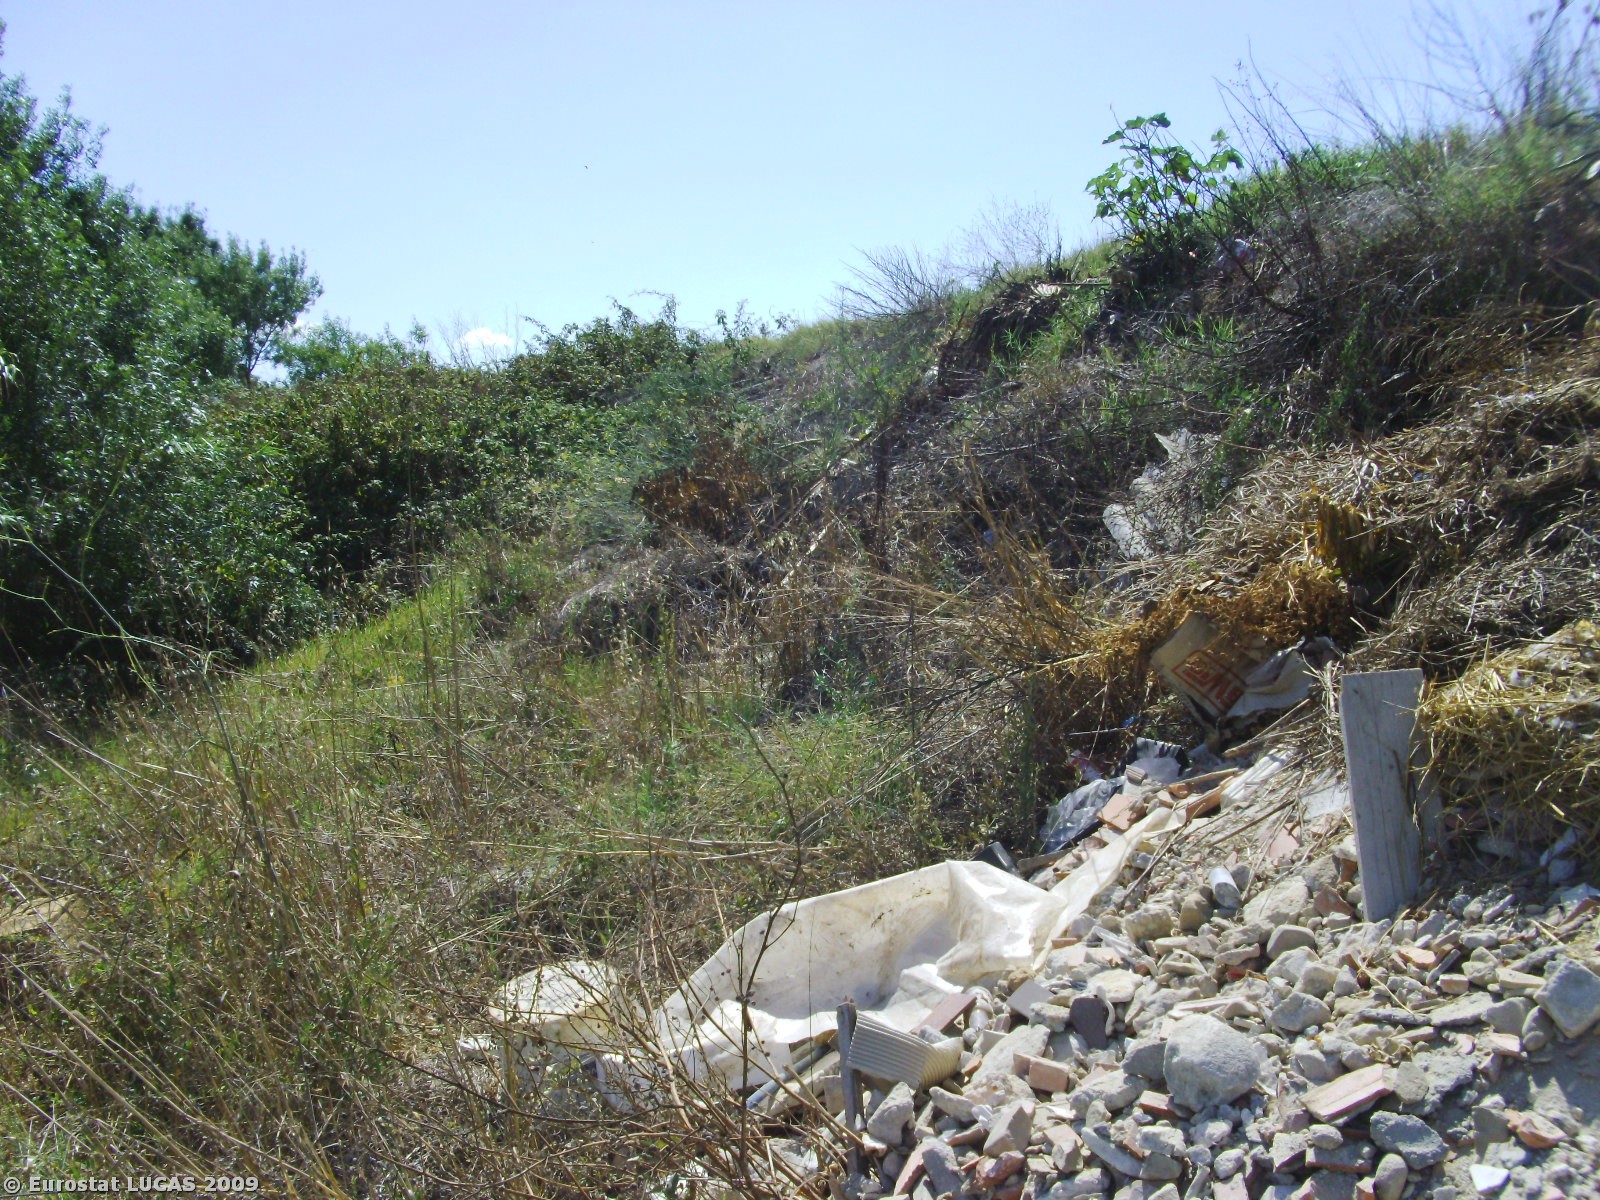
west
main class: Grassland
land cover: Spontaneously vegetated surfaces
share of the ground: 10 - 25 %
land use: Unused
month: July
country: PT
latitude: 38.9767
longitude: -8.7575
